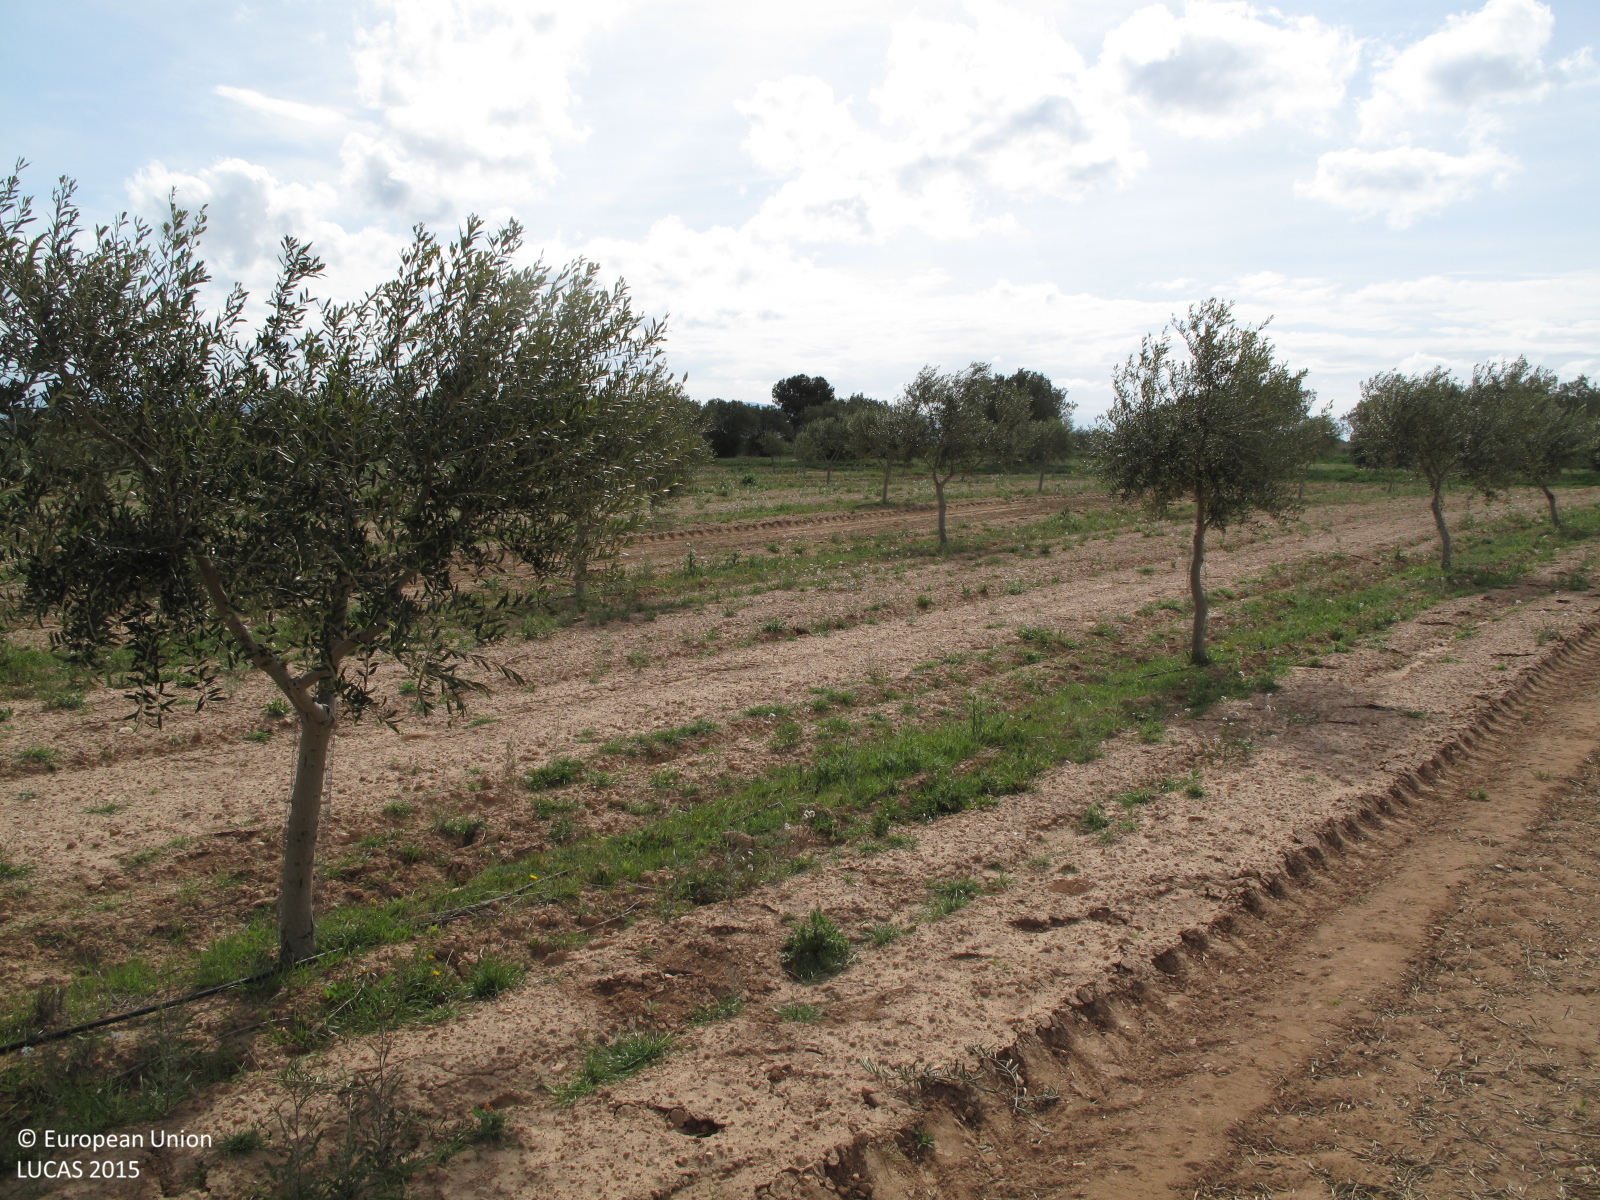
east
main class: Cropland
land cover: Olive groves
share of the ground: < 10 %
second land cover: Spontaneously vegetated surfaces
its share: < 10 %
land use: Agriculture (excluding fallow land and kitchen gardens)
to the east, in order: Olive groves; Spontaneously vegetated surfaces; Tracks; Grass margins; Olive groves; Shruby margins; Tracks; Shruby margins; Barley
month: April
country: ES
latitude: 38.6649
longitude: -0.9666
